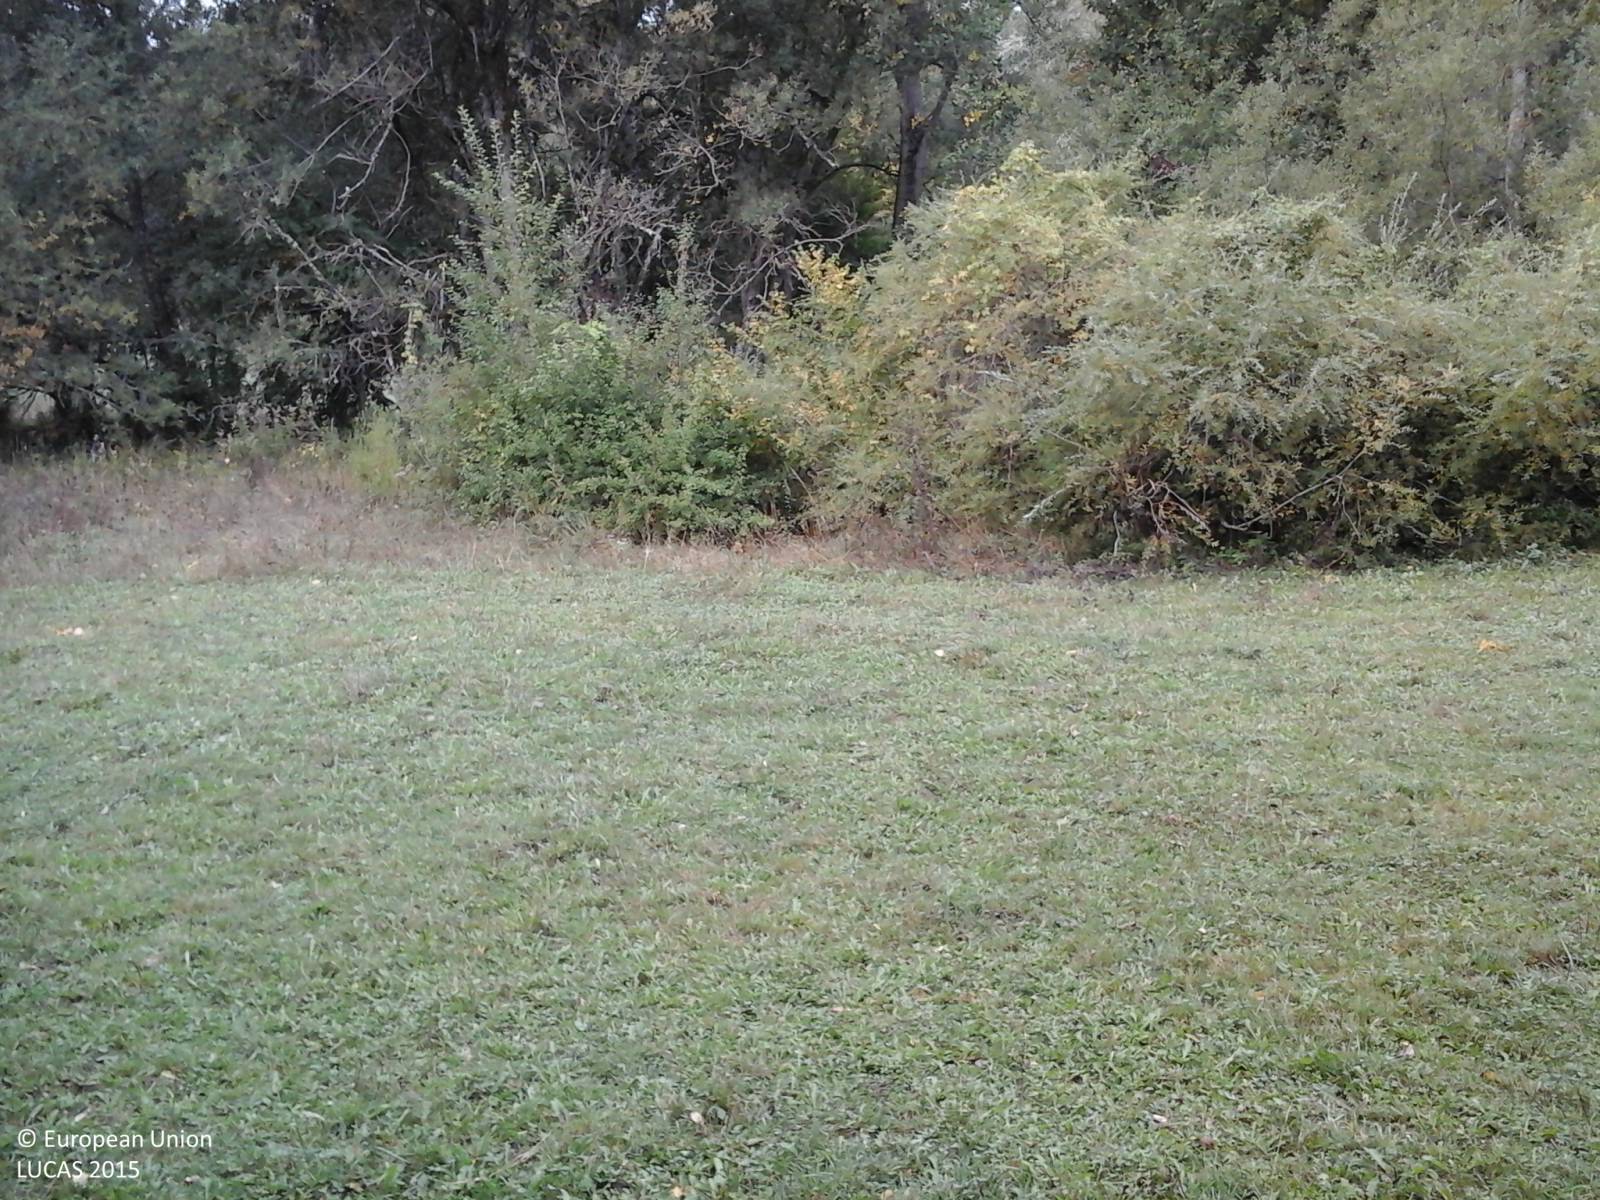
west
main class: Grassland
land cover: Grassland without tree/shrub cover
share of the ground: > 75 %
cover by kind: herbaceous plants 100 %
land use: Agriculture (excluding fallow land and kitchen gardens)
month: October
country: IT
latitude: 42.6021
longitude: 13.2443
